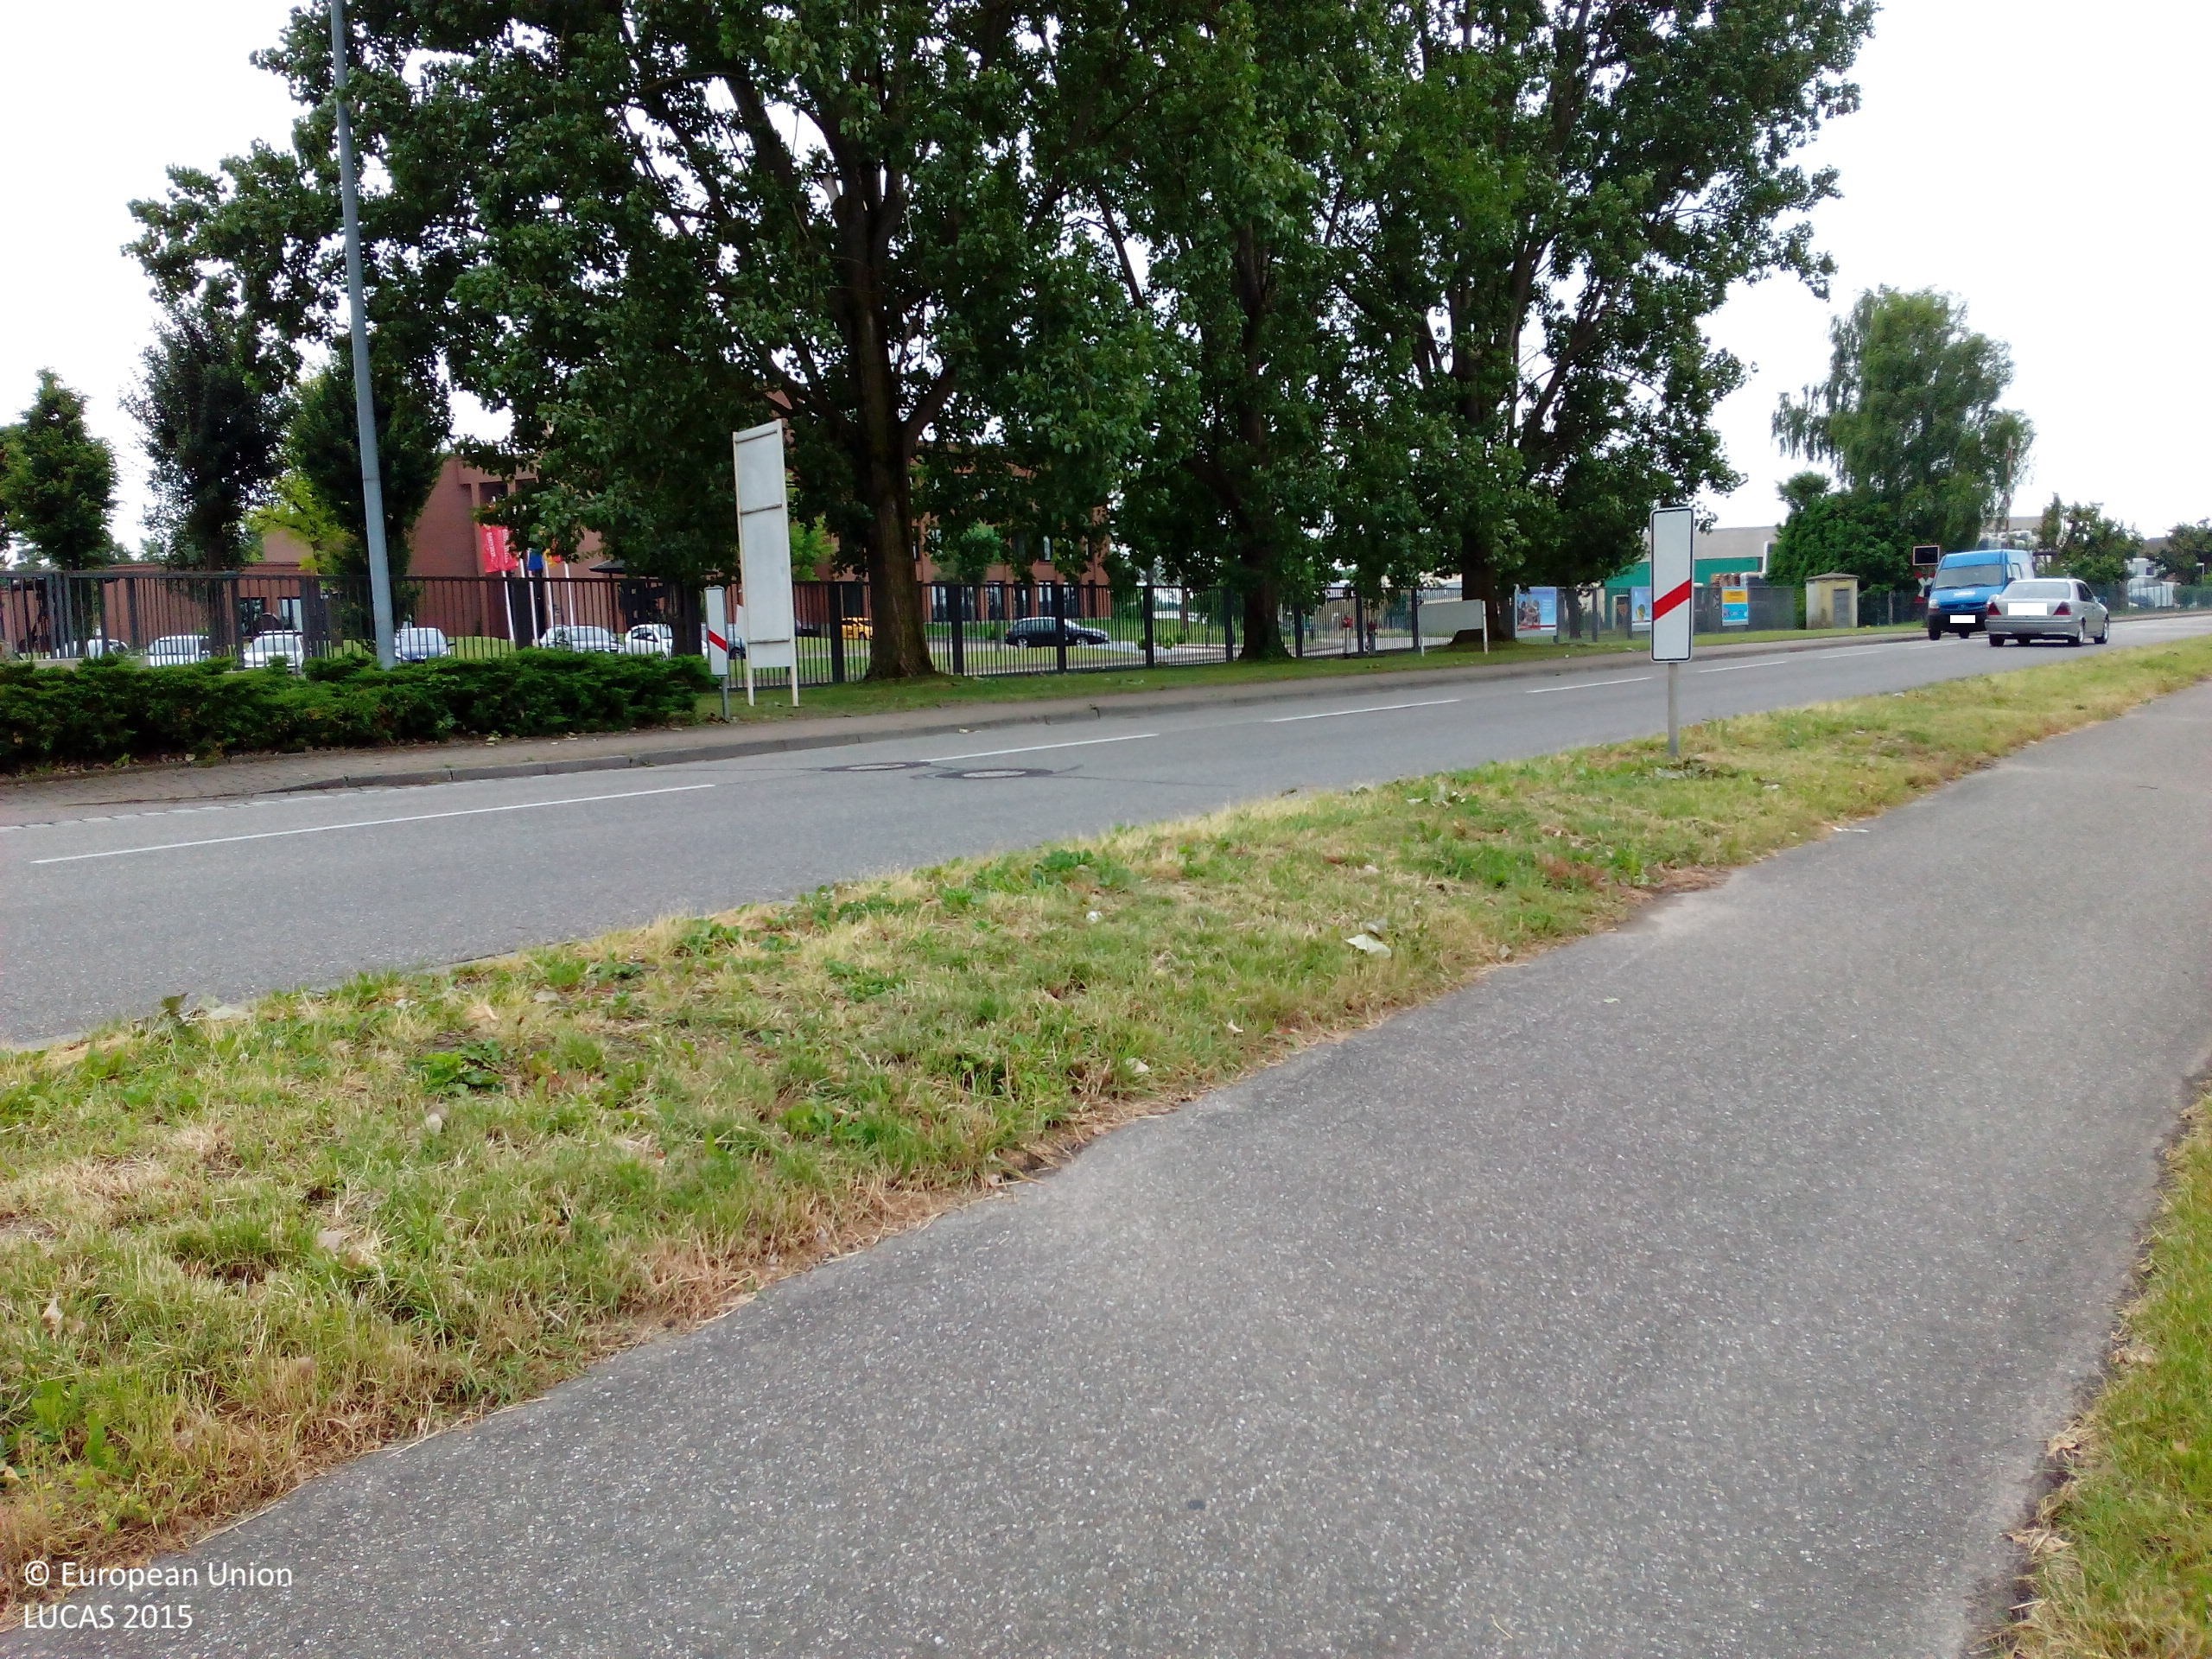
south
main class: Cropland
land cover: Durum wheat
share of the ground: > 75 %
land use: Agriculture (excluding fallow land and kitchen gardens)
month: June
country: DE
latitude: 48.0354
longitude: 7.6005
